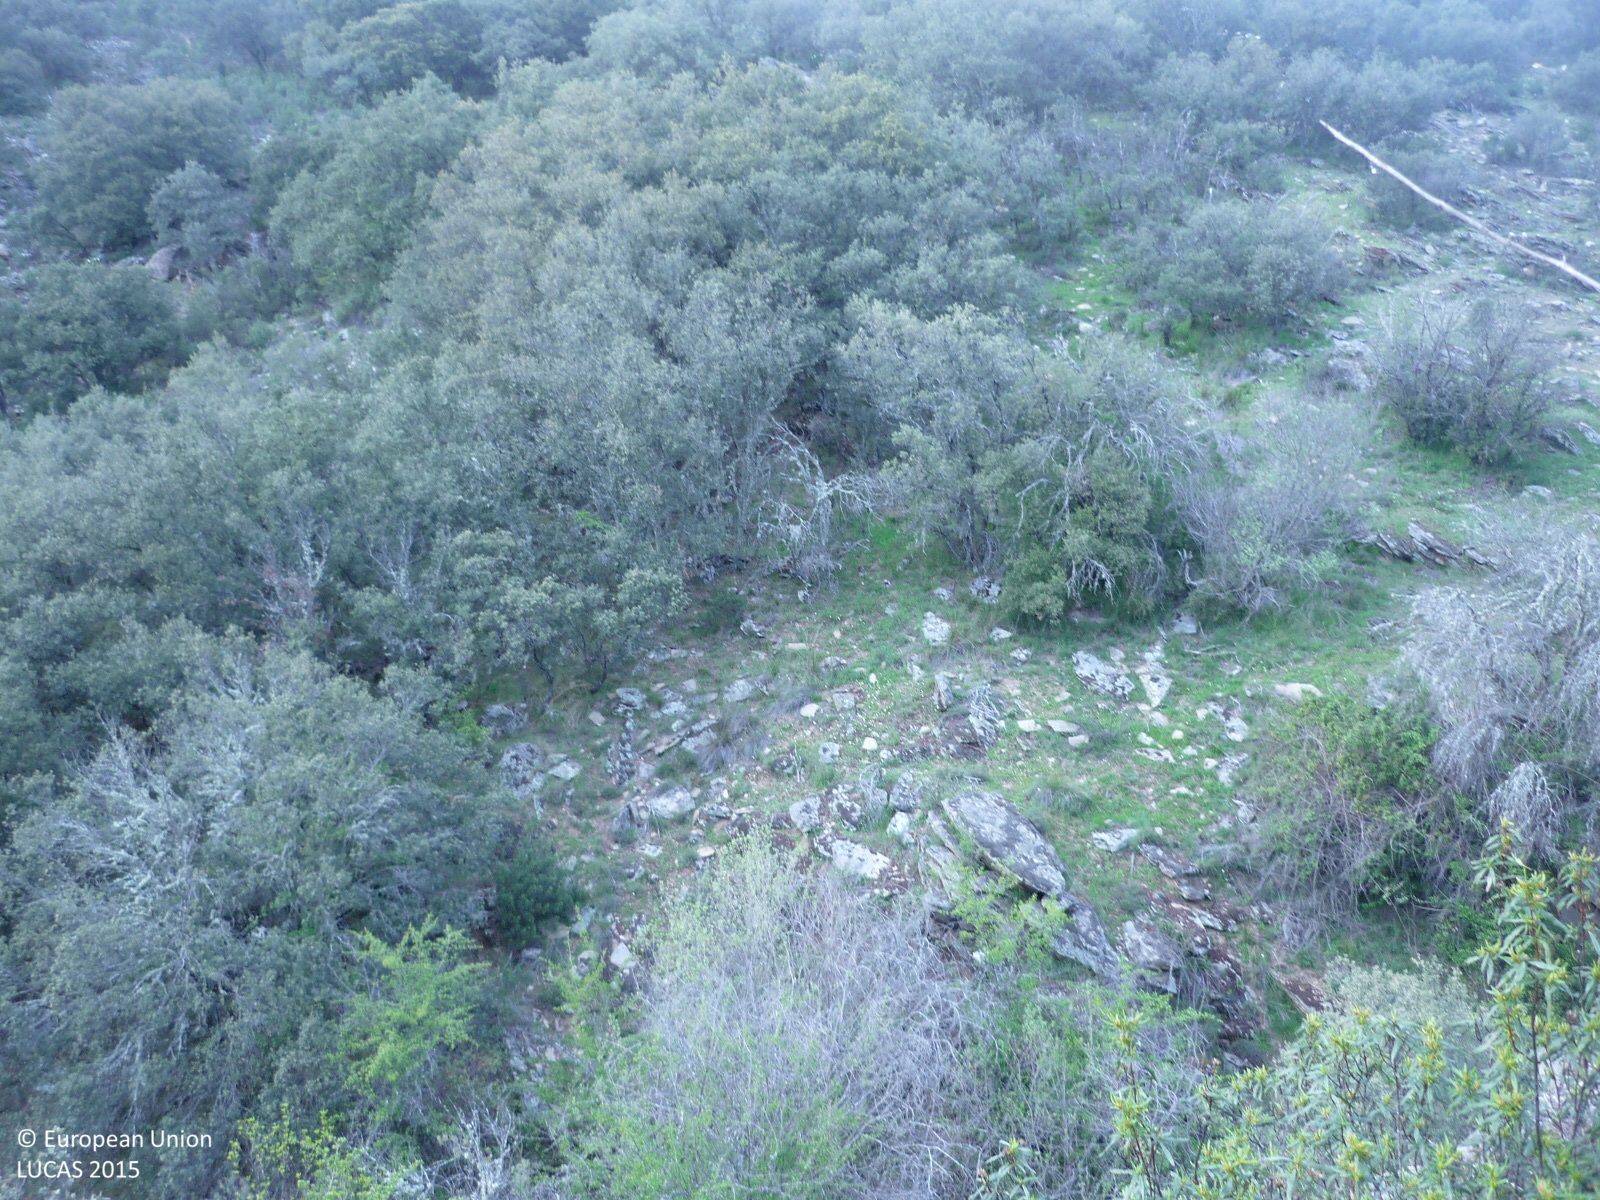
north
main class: Woodland
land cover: Broadleaved woodland
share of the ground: 50 - 75 %
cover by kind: broadleaved forest trees 50 %, herbaceous plants 30 %, shrubs 20 %
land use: Semi-natural and natural areas not in use
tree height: < 5 m
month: April
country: ES
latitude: 40.9877
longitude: -3.5575
